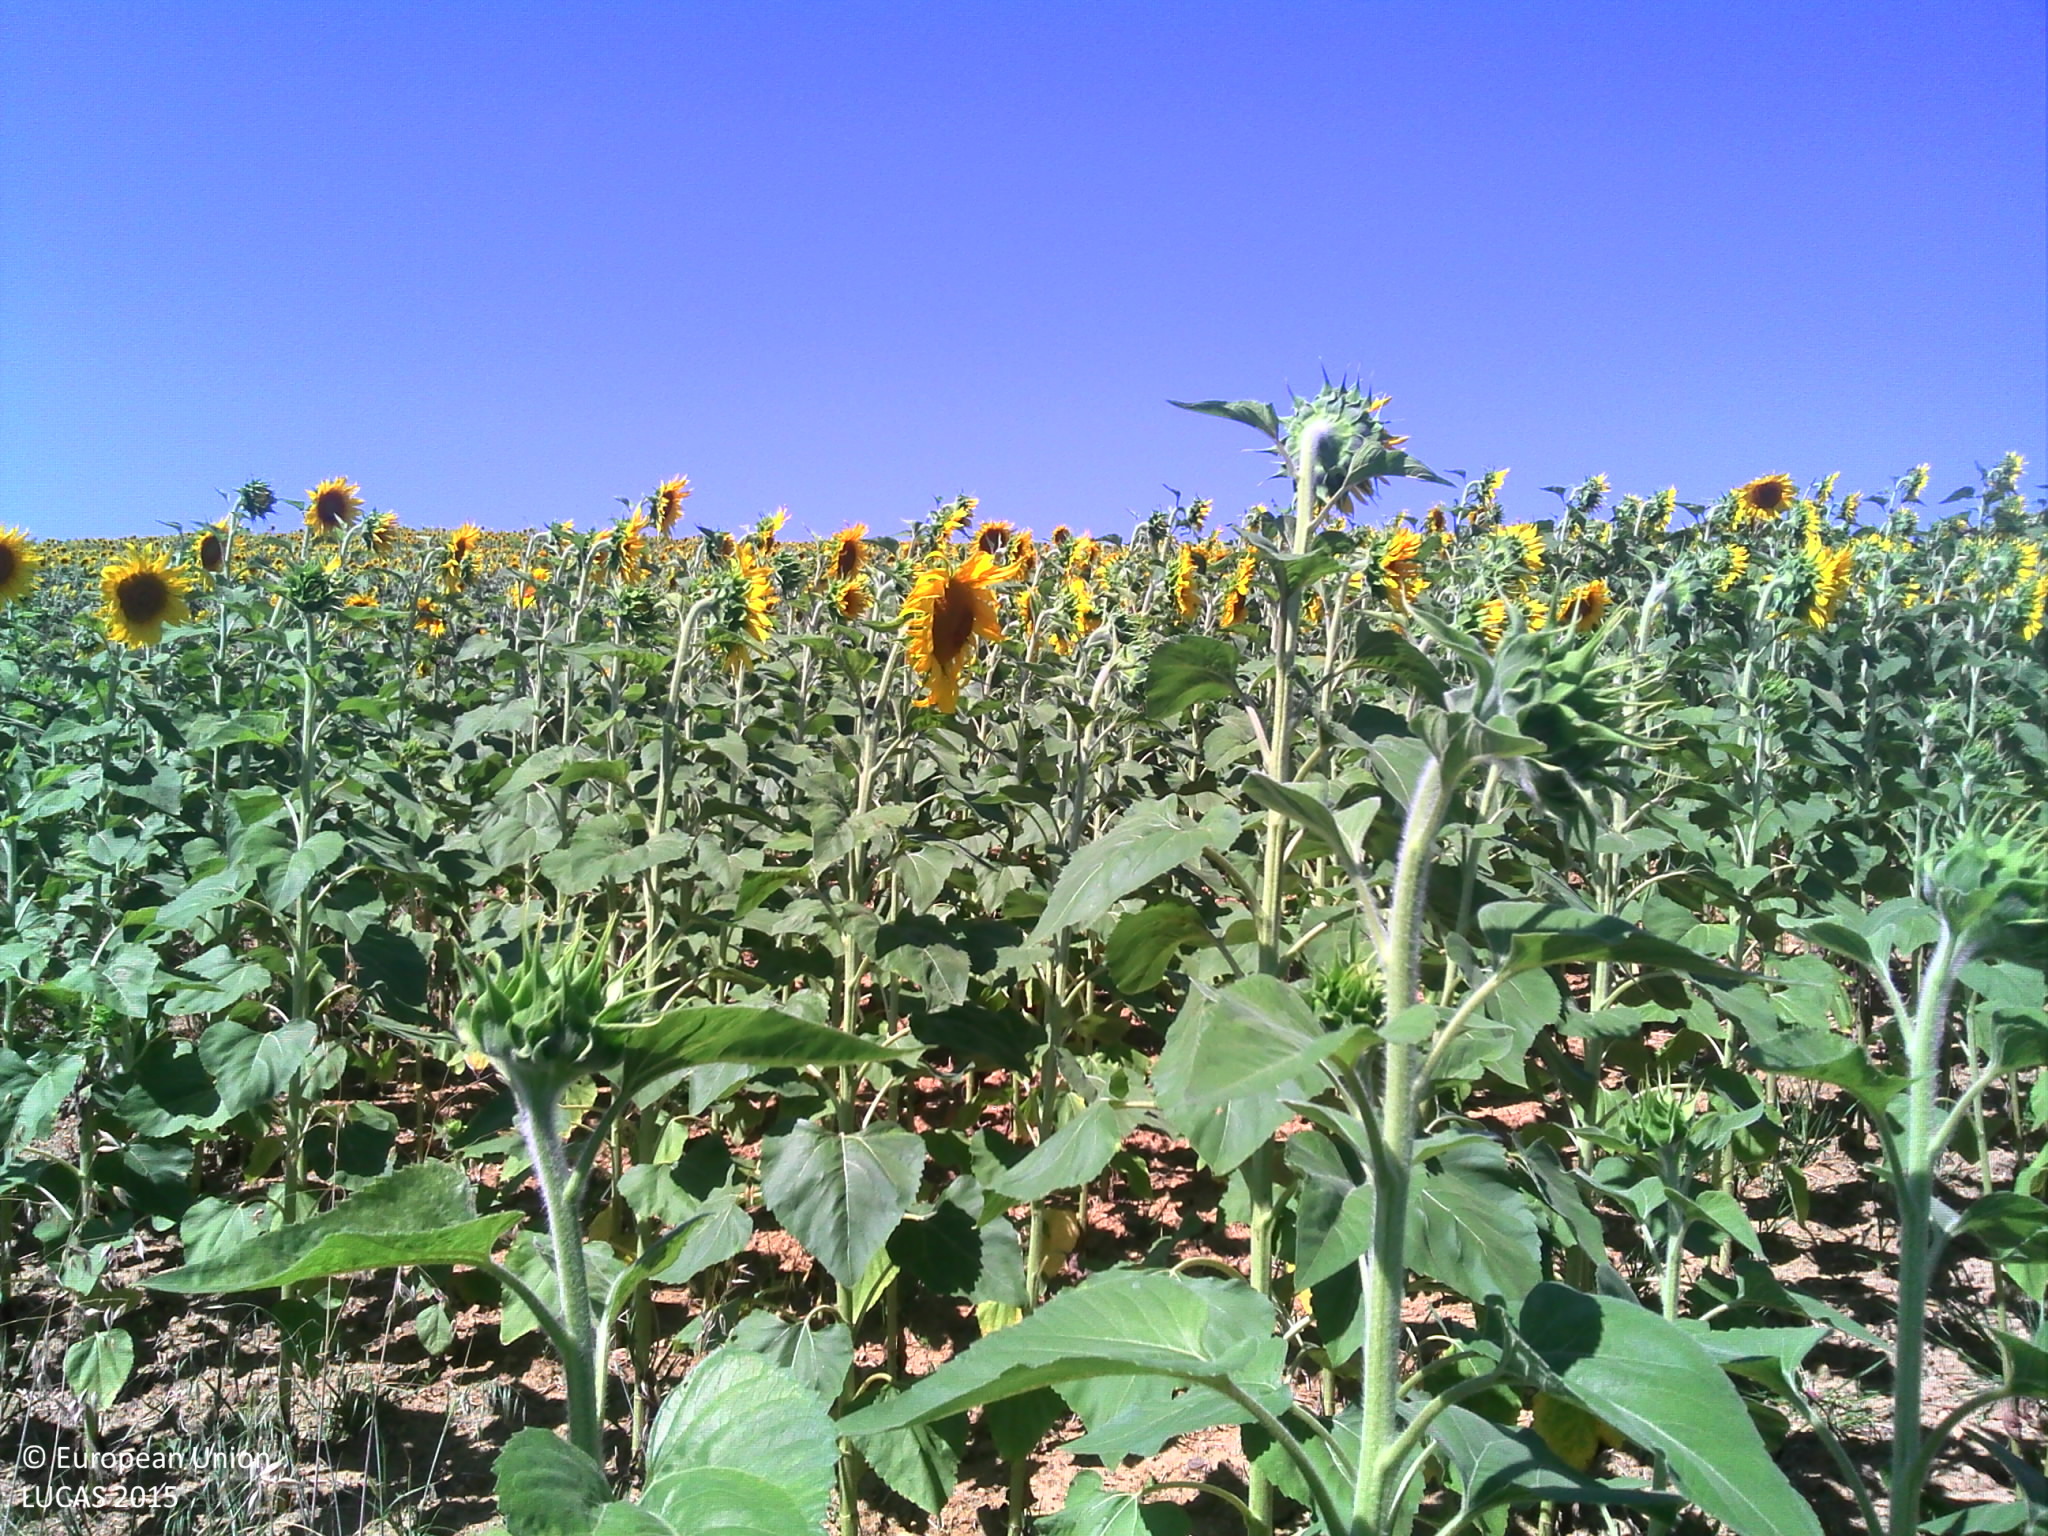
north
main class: Cropland
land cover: Sunflower
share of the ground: > 75 %
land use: Agriculture (excluding fallow land and kitchen gardens)
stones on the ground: < 10 %
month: July
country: FR
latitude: 43.2113
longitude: 0.7573
